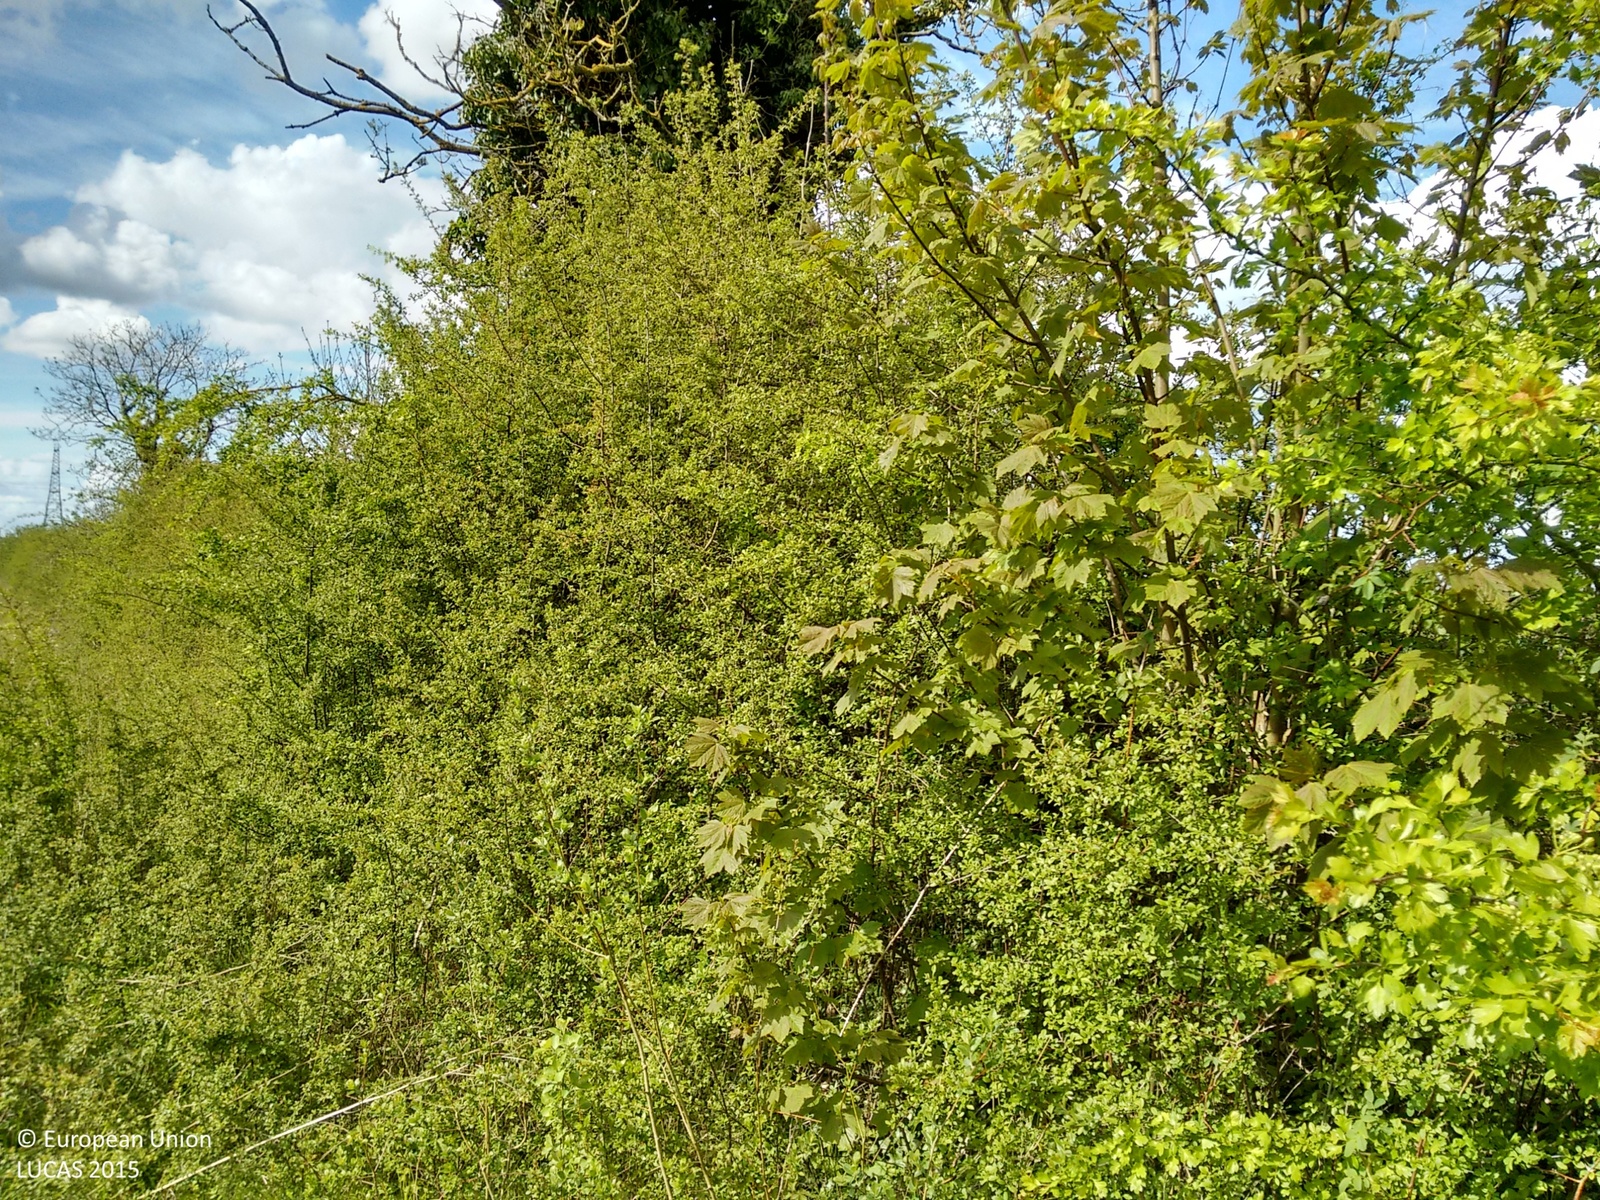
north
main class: Woodland
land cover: Broadleaved woodland
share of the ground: > 75 %
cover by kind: broadleaved forest trees 50 %, herbaceous plants 50 %
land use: Semi-natural and natural areas not in use
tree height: < 5 m
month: May
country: GB
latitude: 51.9062
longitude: -0.5480
